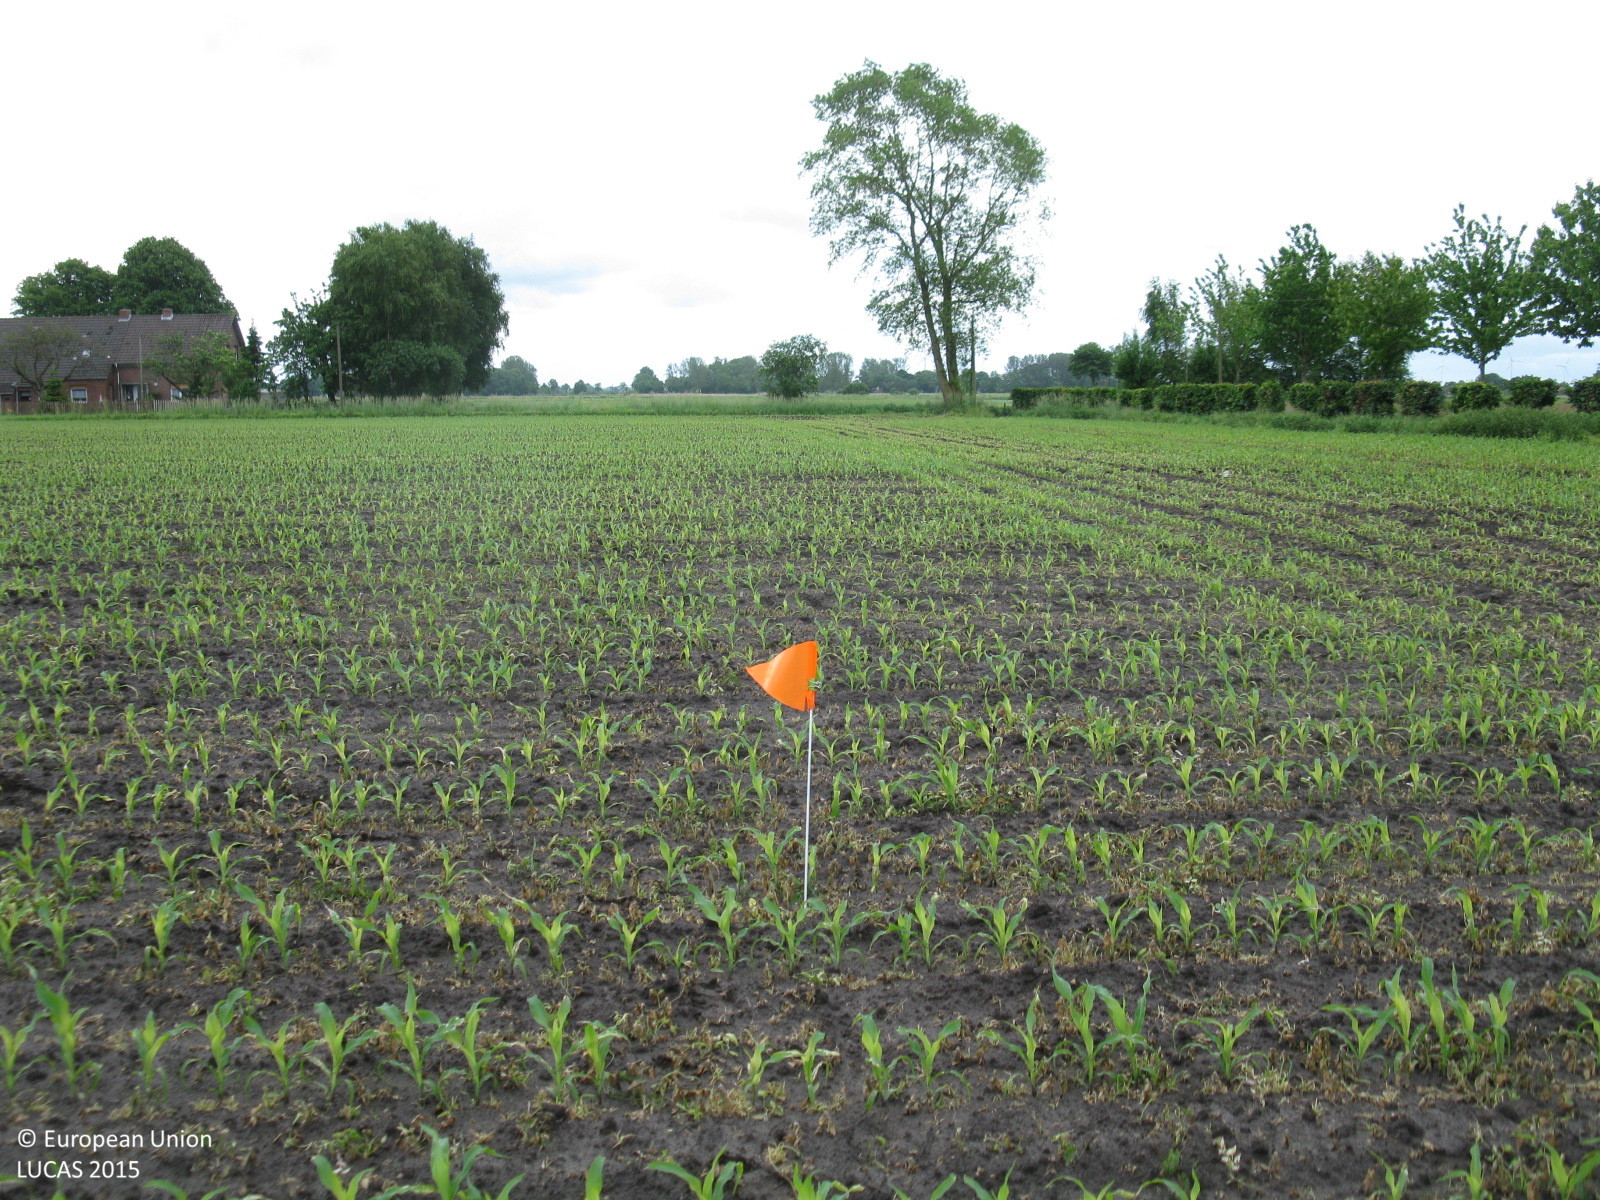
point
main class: Cropland
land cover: Maize
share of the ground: 10 - 25 %
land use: Agriculture (excluding fallow land and kitchen gardens)
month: June
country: DE
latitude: 53.4452
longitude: 7.3658
